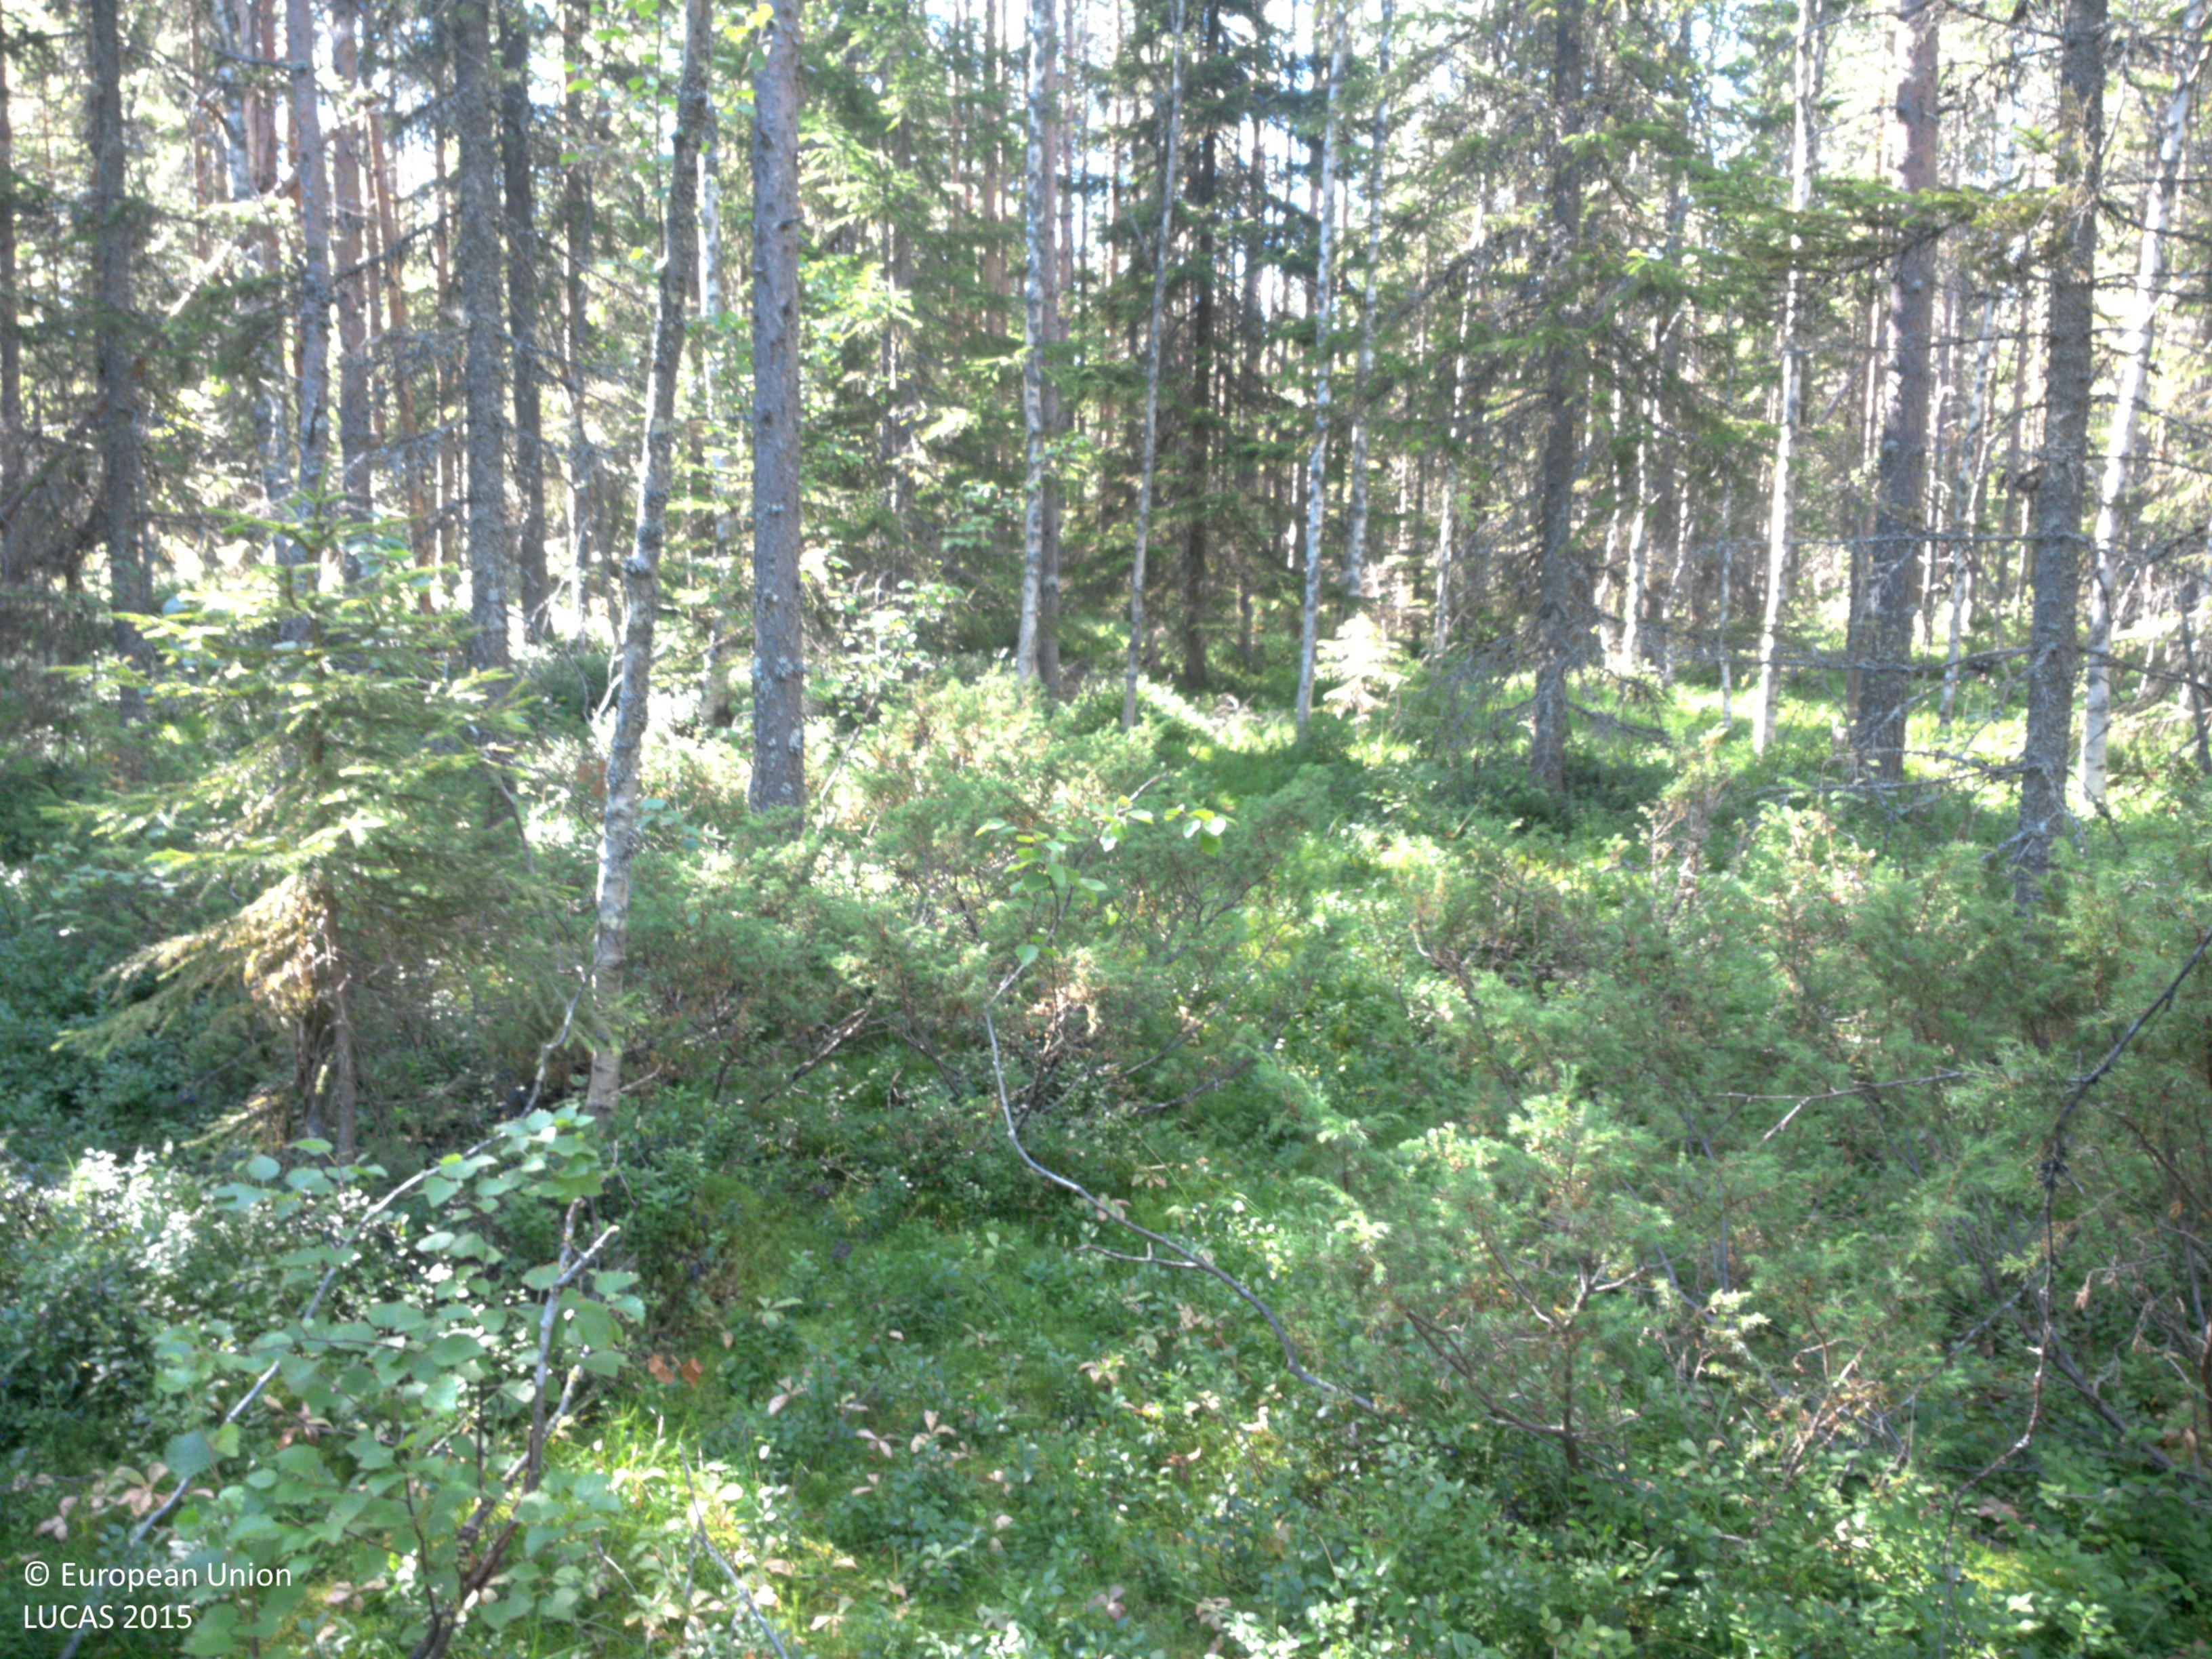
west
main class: Woodland
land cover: Other mixed woodland
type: boreal forest
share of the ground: 50 - 75 %
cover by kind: coniferous forest trees 40 %, shrubs 40 %, broadleaved forest trees 20 %
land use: Forestry
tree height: > 5 m
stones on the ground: < 10 %
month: August
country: SE
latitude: 63.6459
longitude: 19.6917
